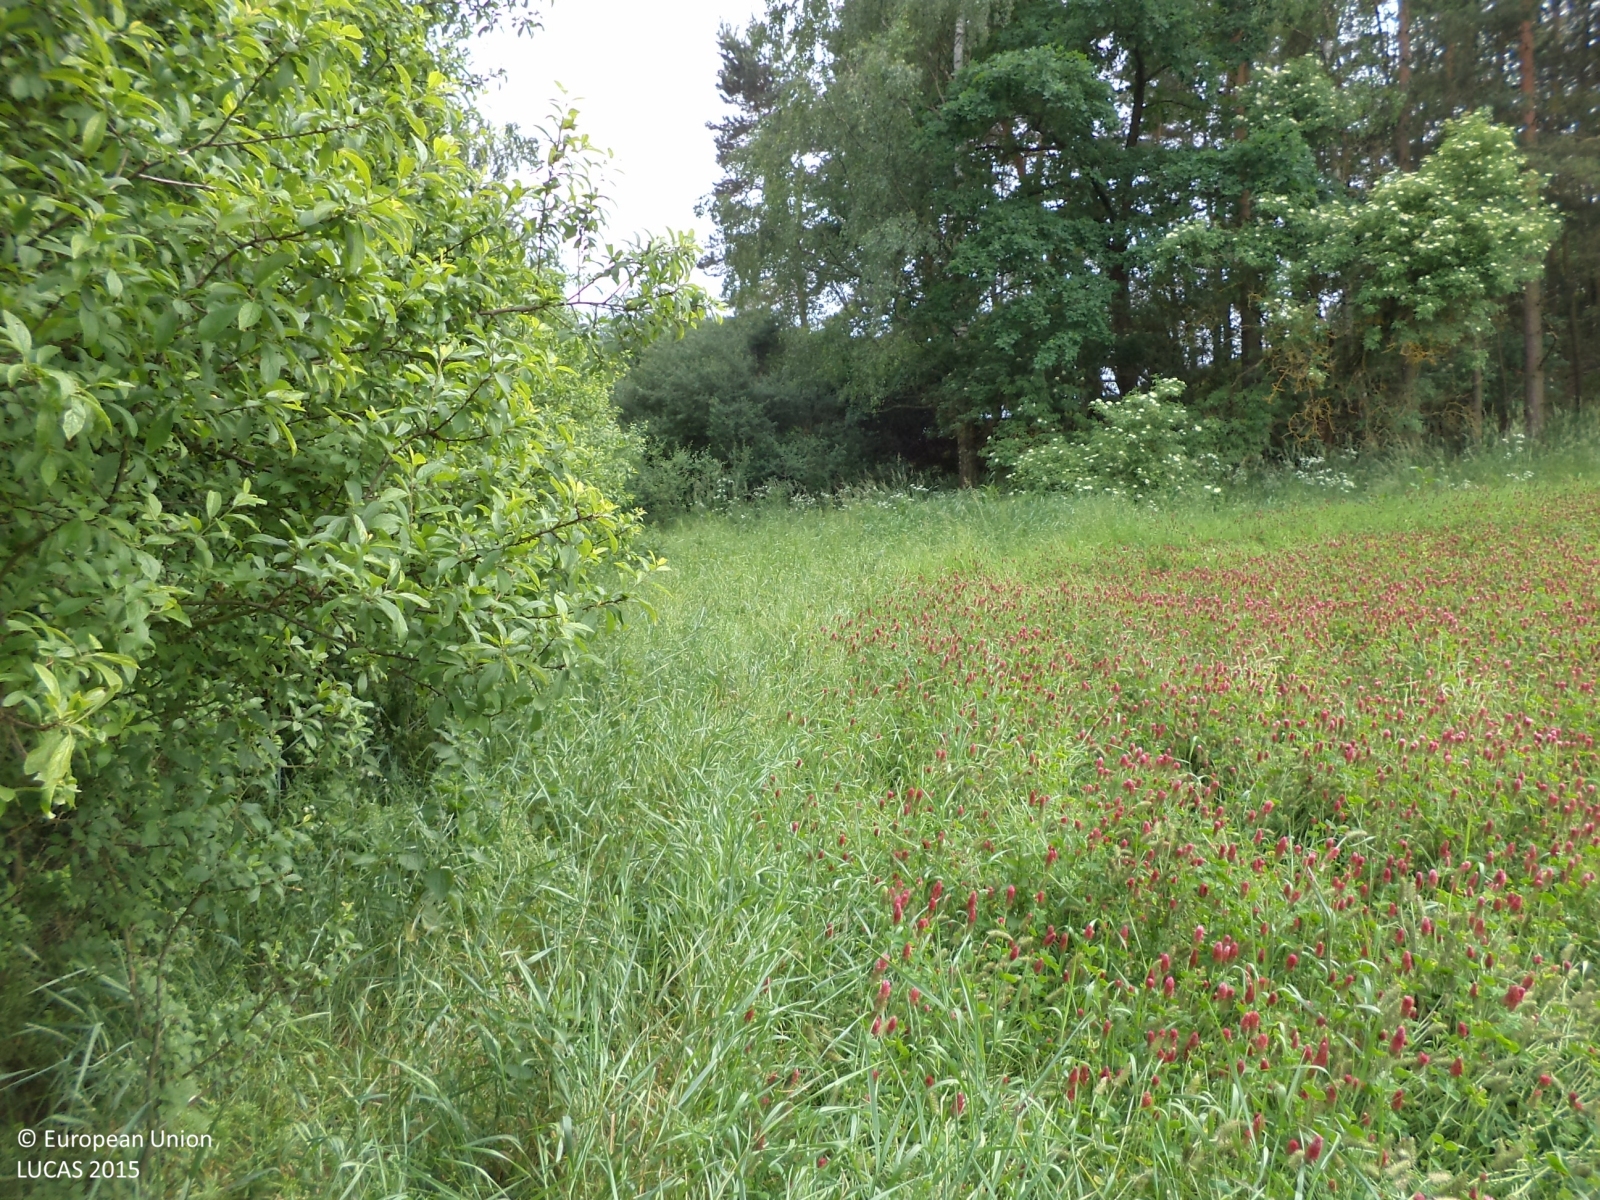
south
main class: Woodland
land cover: Pine dominated mixed woodland
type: hemiboreal forest and nemoral coniferous forest and mixed broadleaved-coniferous forest
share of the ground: > 75 %
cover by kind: coniferous forest trees 60 %, broadleaved forest trees 30 %, shrubs 10 %
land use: Forestry
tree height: > 5 m
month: June
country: CZ
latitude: 49.1975
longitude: 14.4338
